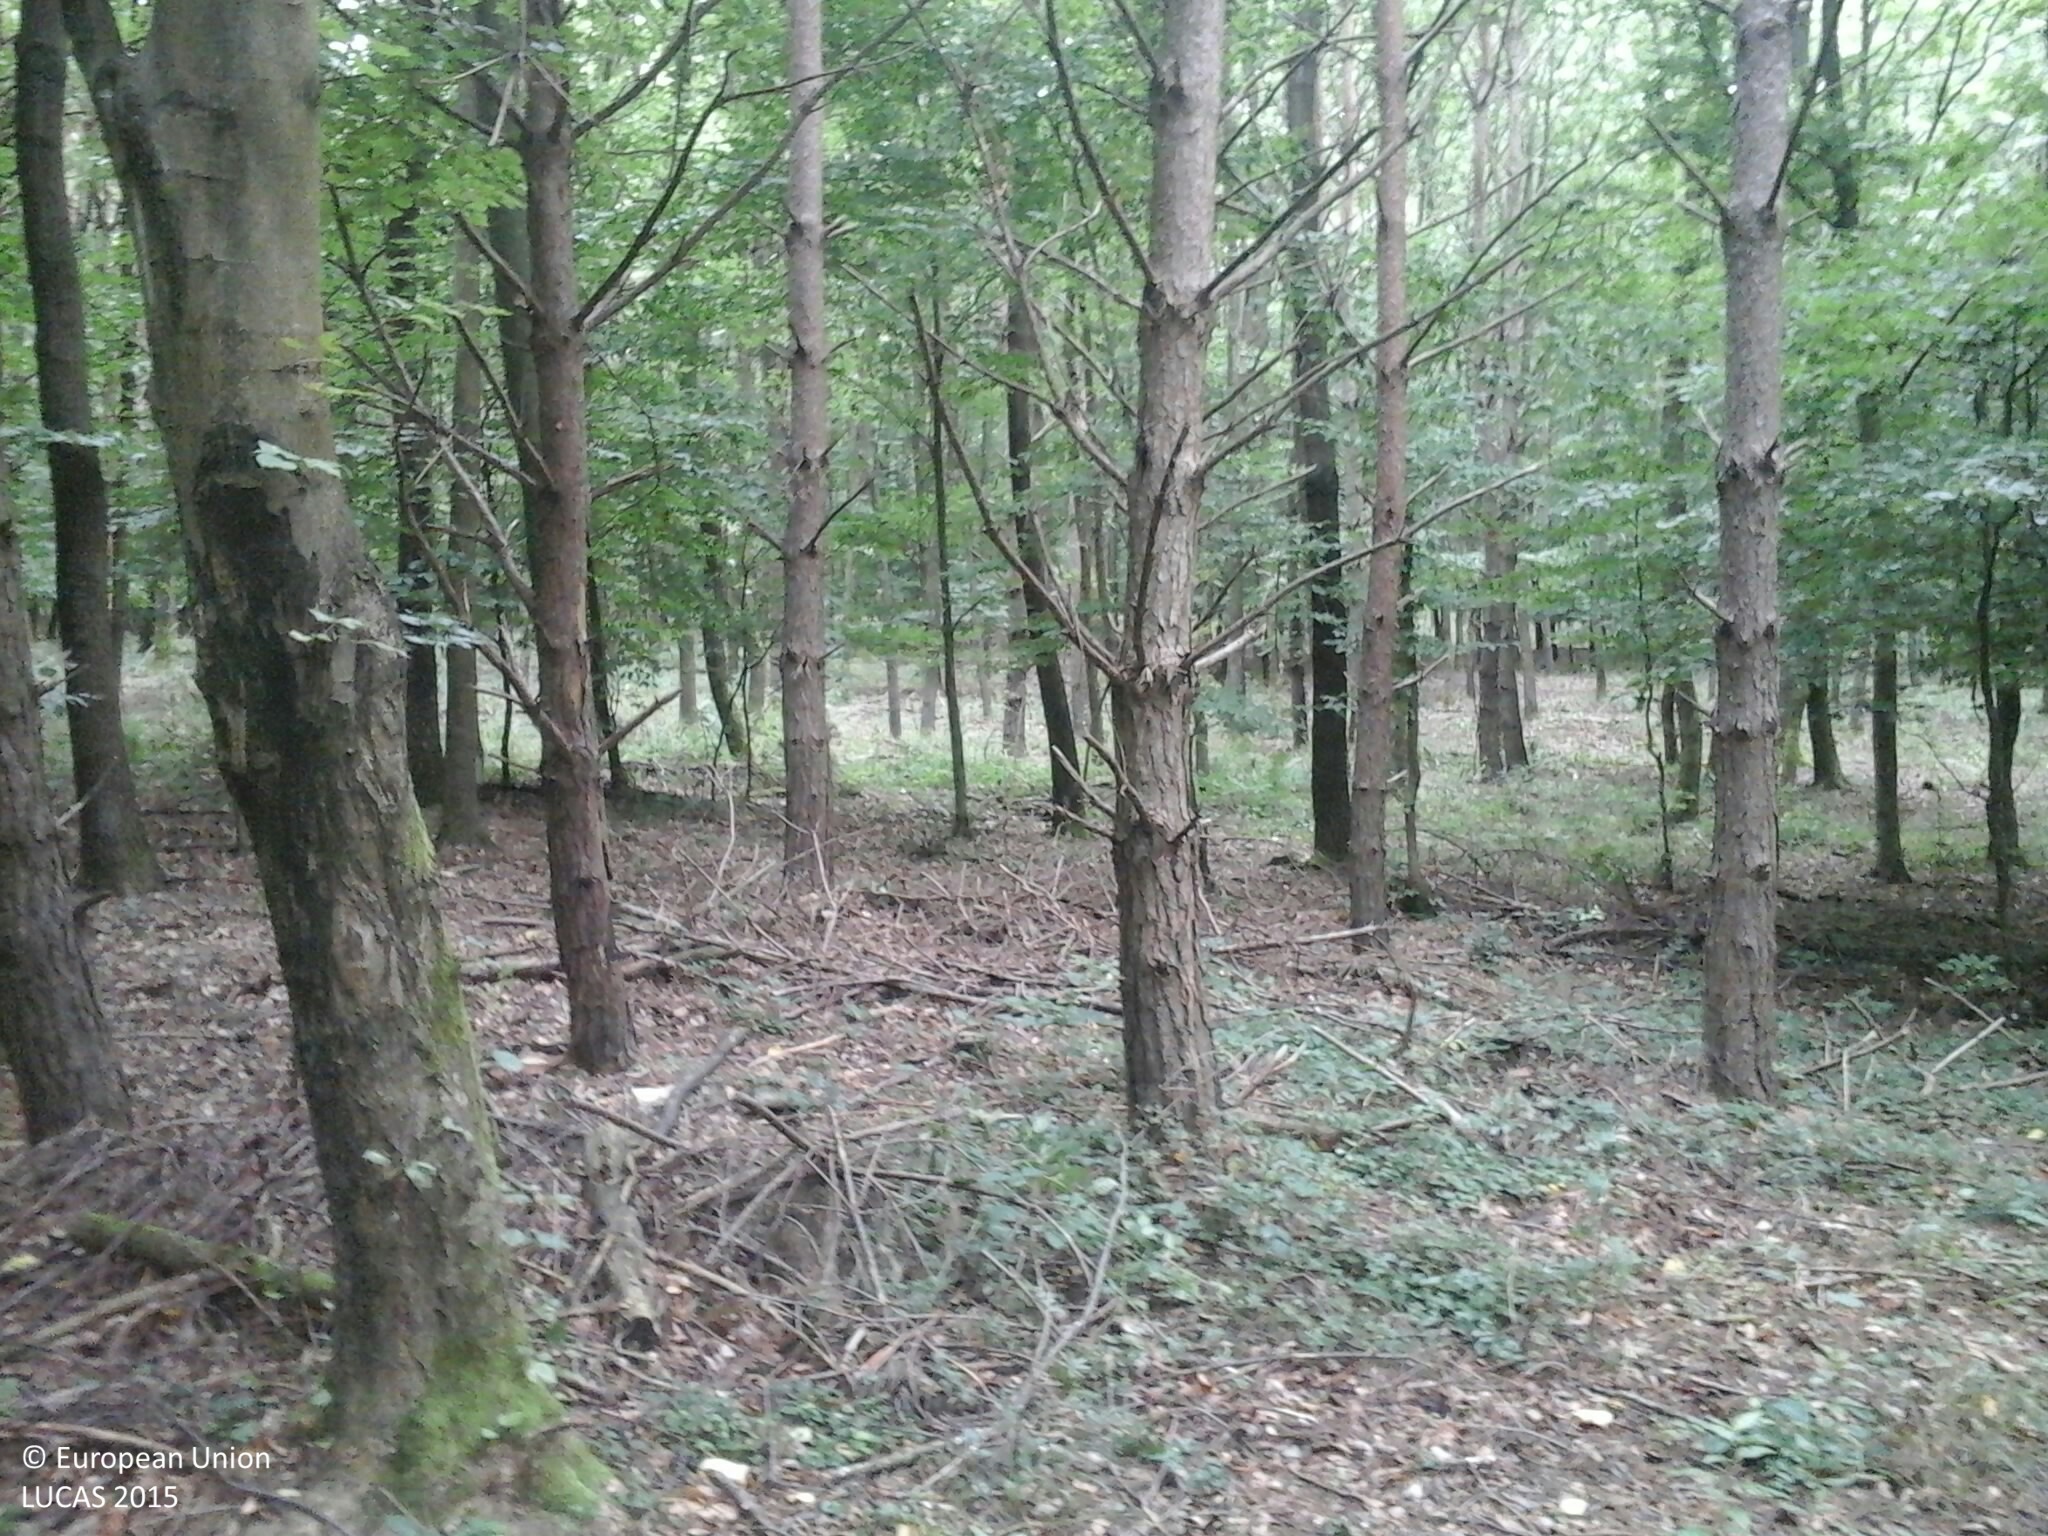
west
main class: Woodland
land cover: Pine dominated mixed woodland
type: hemiboreal forest and nemoral coniferous forest and mixed broadleaved-coniferous forest
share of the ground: > 75 %
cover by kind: coniferous forest trees 50 %, broadleaved forest trees 40 %, shrubs 5 %, herbaceous plants 5 %
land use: Forestry
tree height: > 5 m
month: July
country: HU
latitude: 46.7998
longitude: 16.5665
